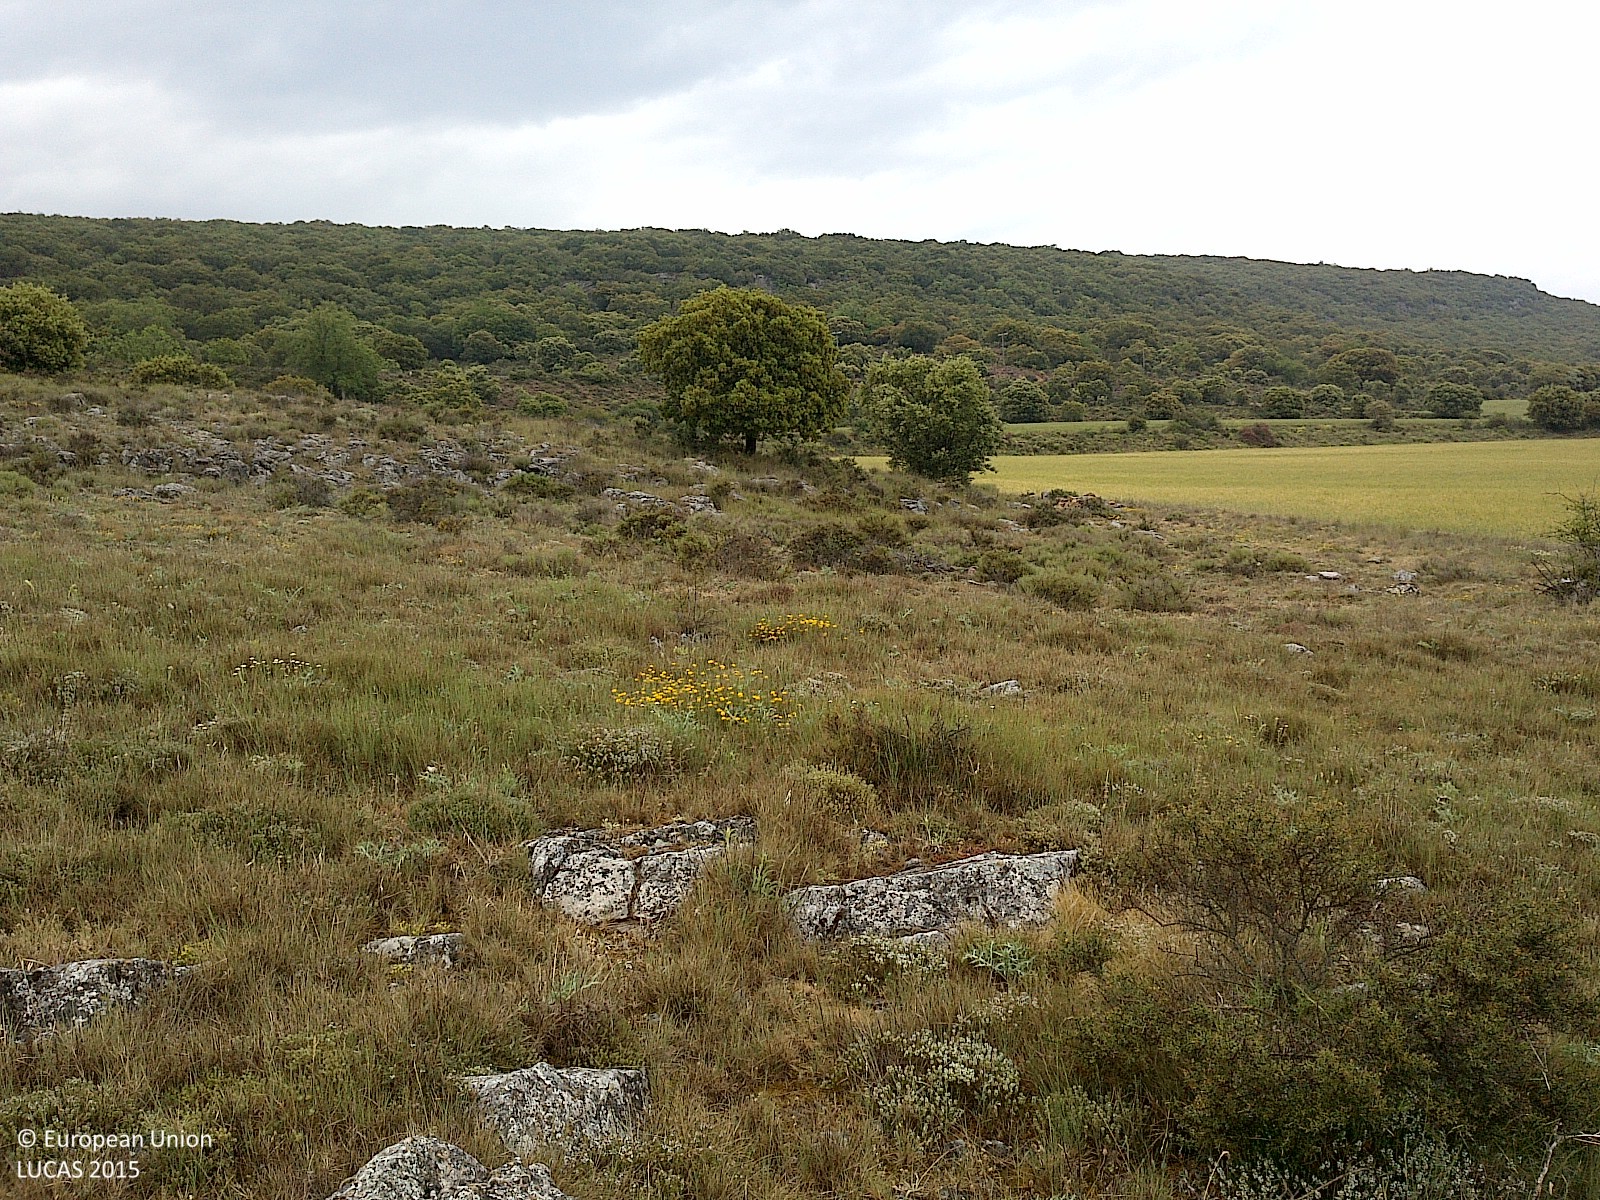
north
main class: Grassland
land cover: Grassland without tree/shrub cover
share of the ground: > 75 %
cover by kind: herbaceous plants 85 %, consolidated bare surface 10 %, shrubs 5 %
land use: Semi-natural and natural areas not in use
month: May
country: ES
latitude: 41.7858
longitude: -2.2001
